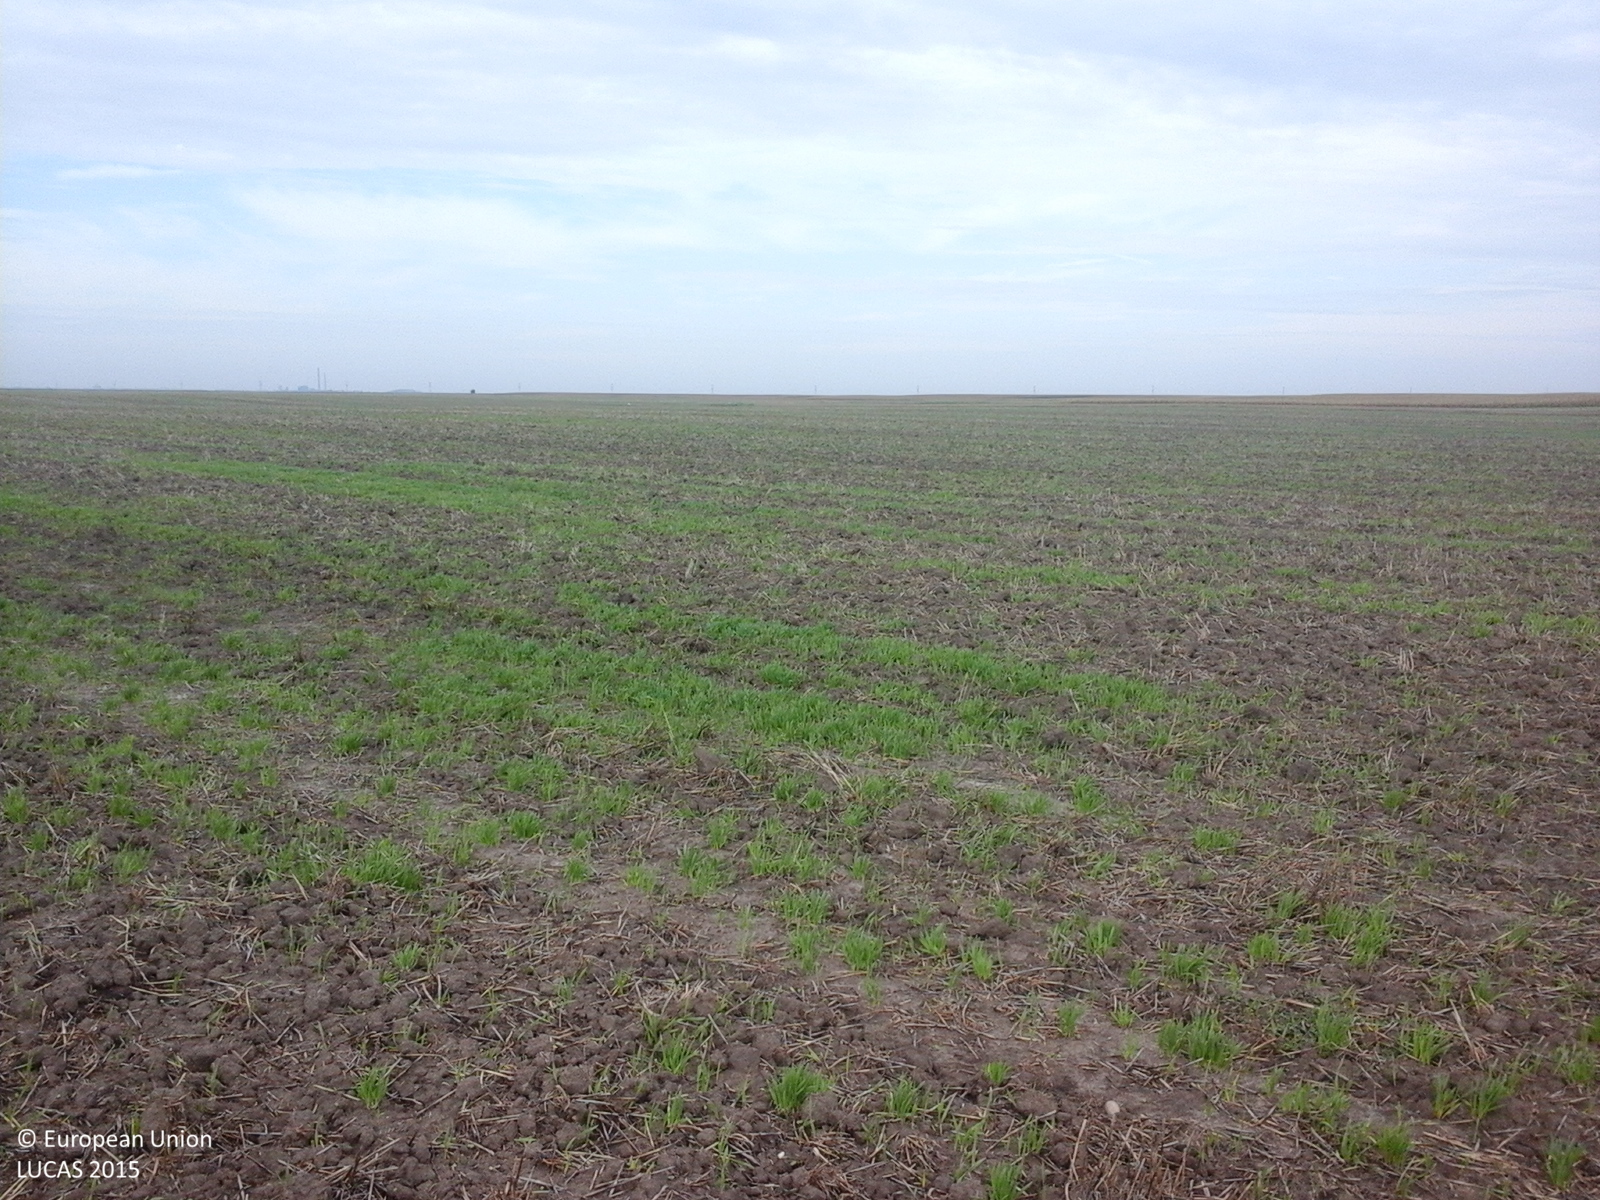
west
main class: Cropland
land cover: Common wheat
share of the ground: < 10 %
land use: Agriculture (excluding fallow land and kitchen gardens)
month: August
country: RO
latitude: 46.2570
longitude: 21.4912
